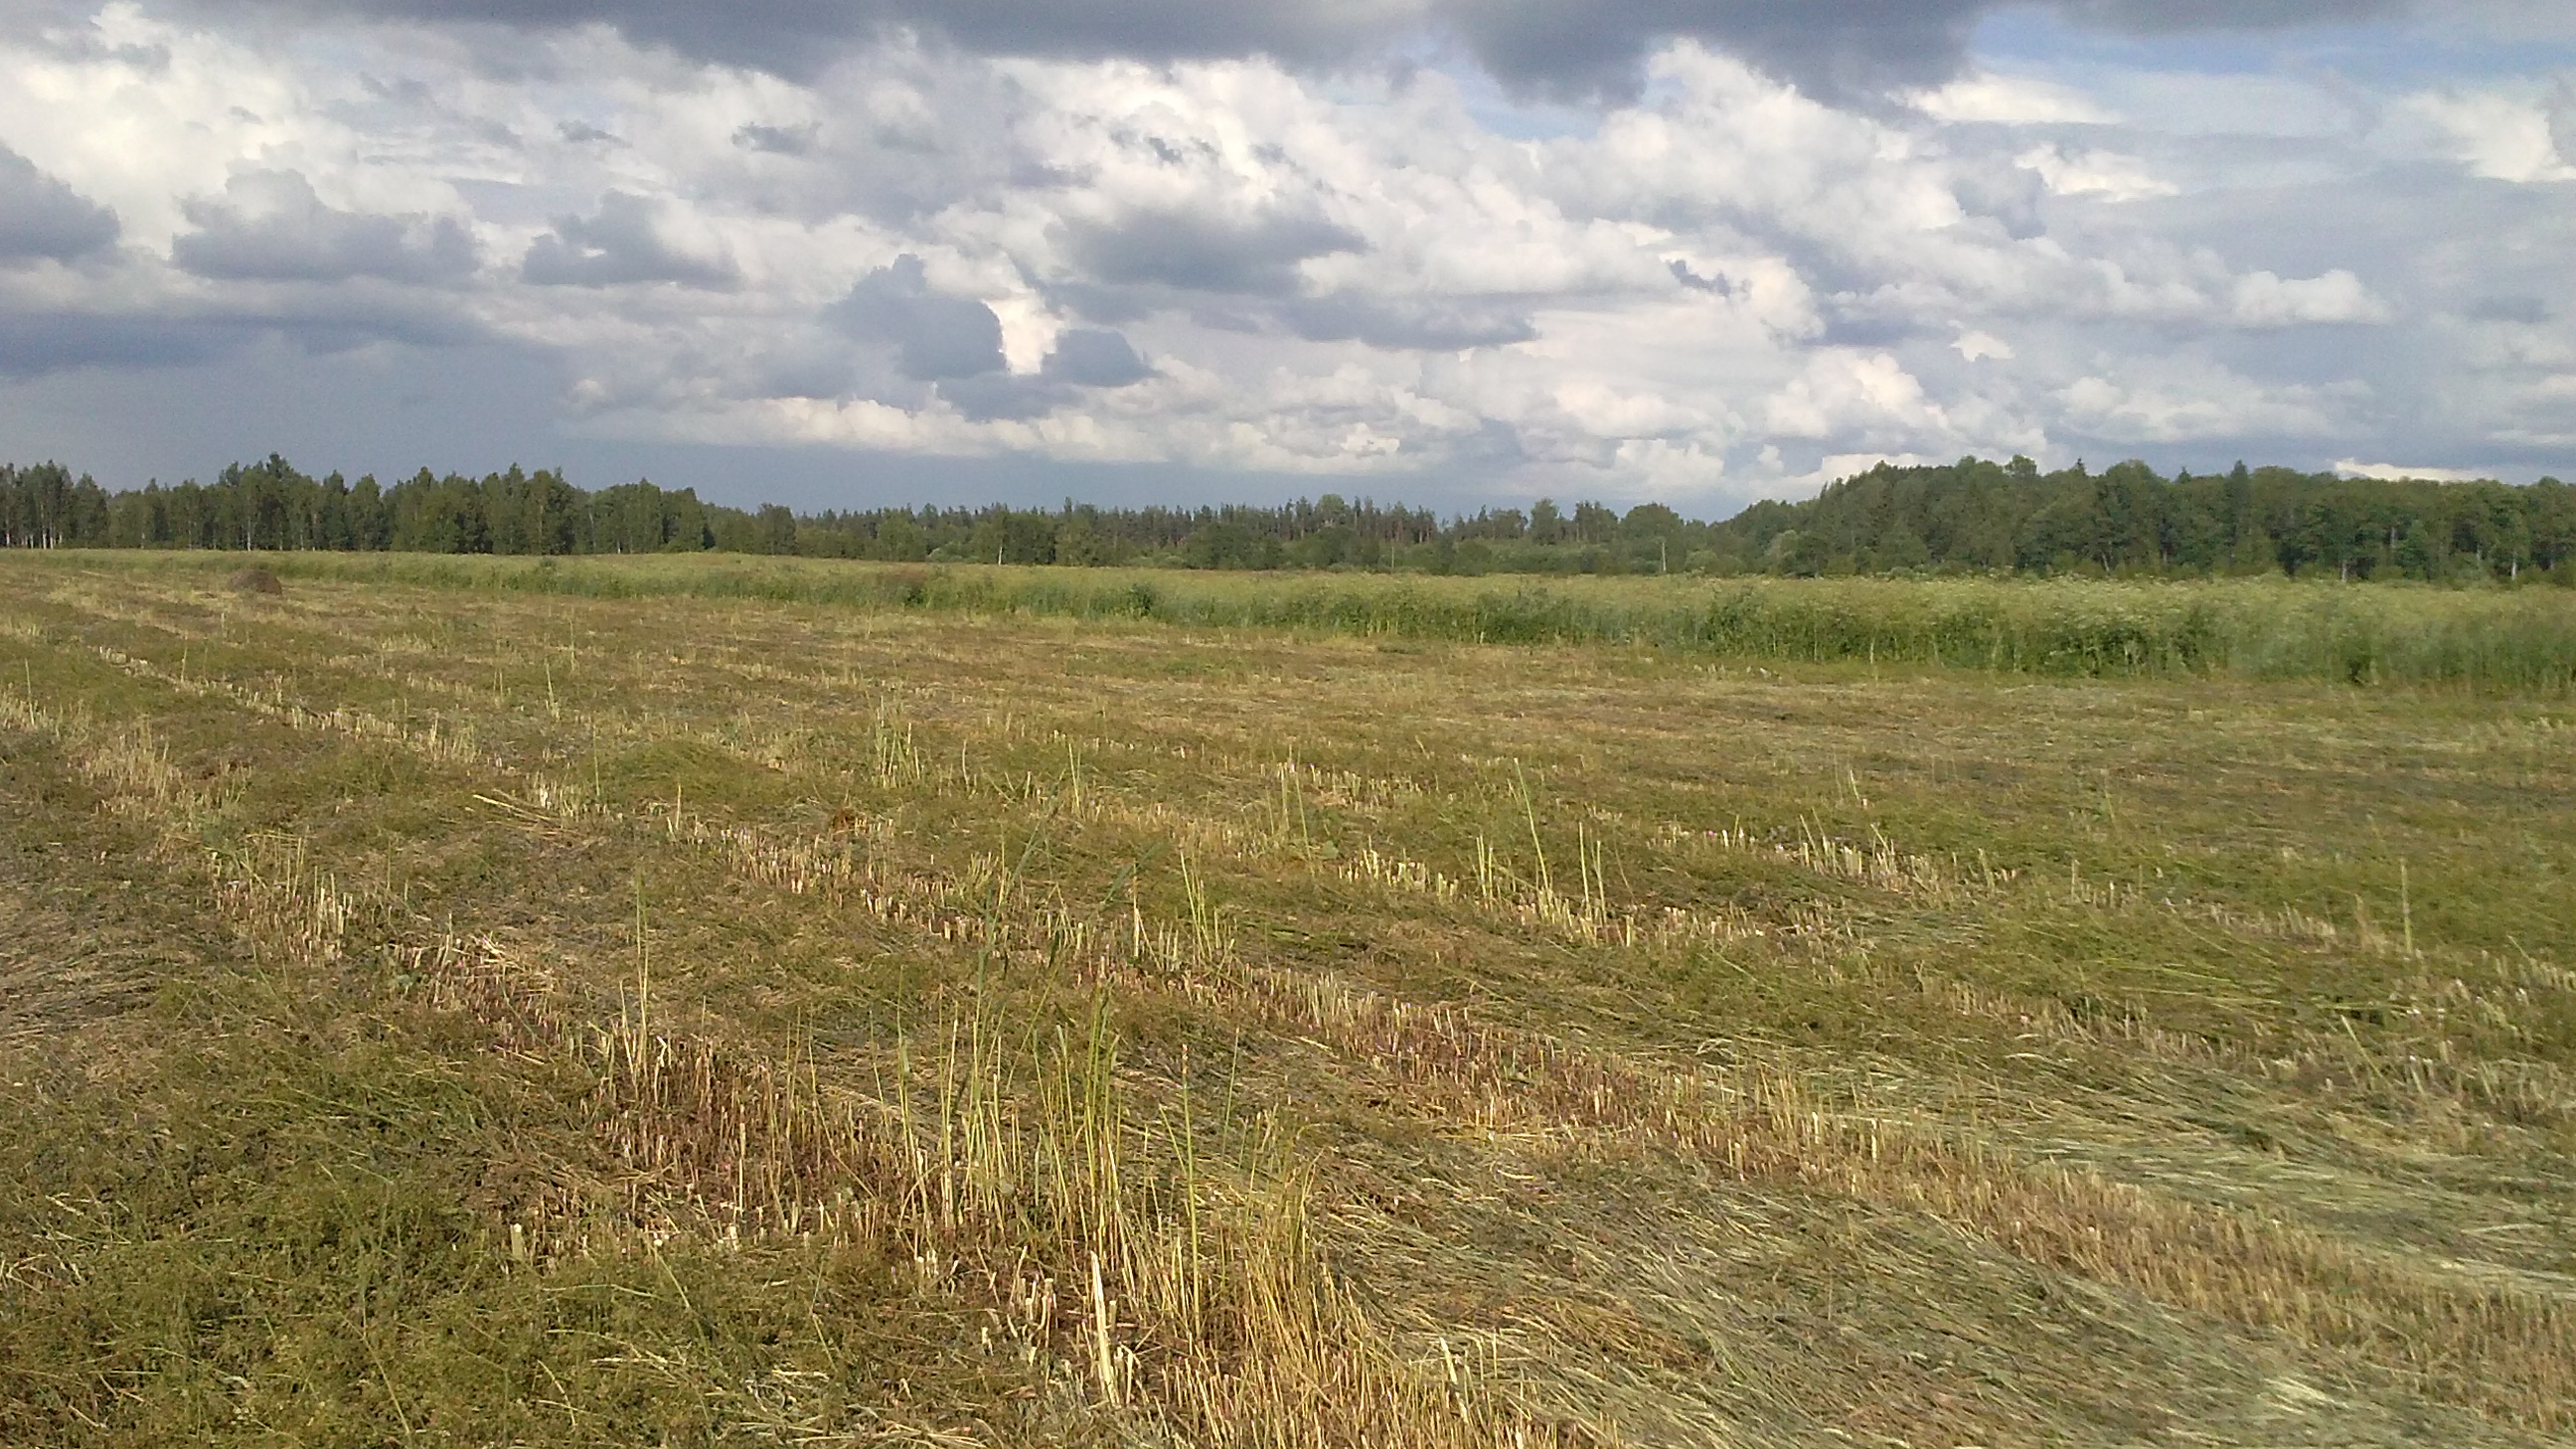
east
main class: Grassland
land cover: Grassland without tree/shrub cover
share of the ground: > 75 %
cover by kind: herbaceous plants 100 %
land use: Agriculture (excluding fallow land and kitchen gardens)
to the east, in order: Grassland without tree/shrub cover
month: June
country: LV
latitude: 56.6562
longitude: 27.8571
